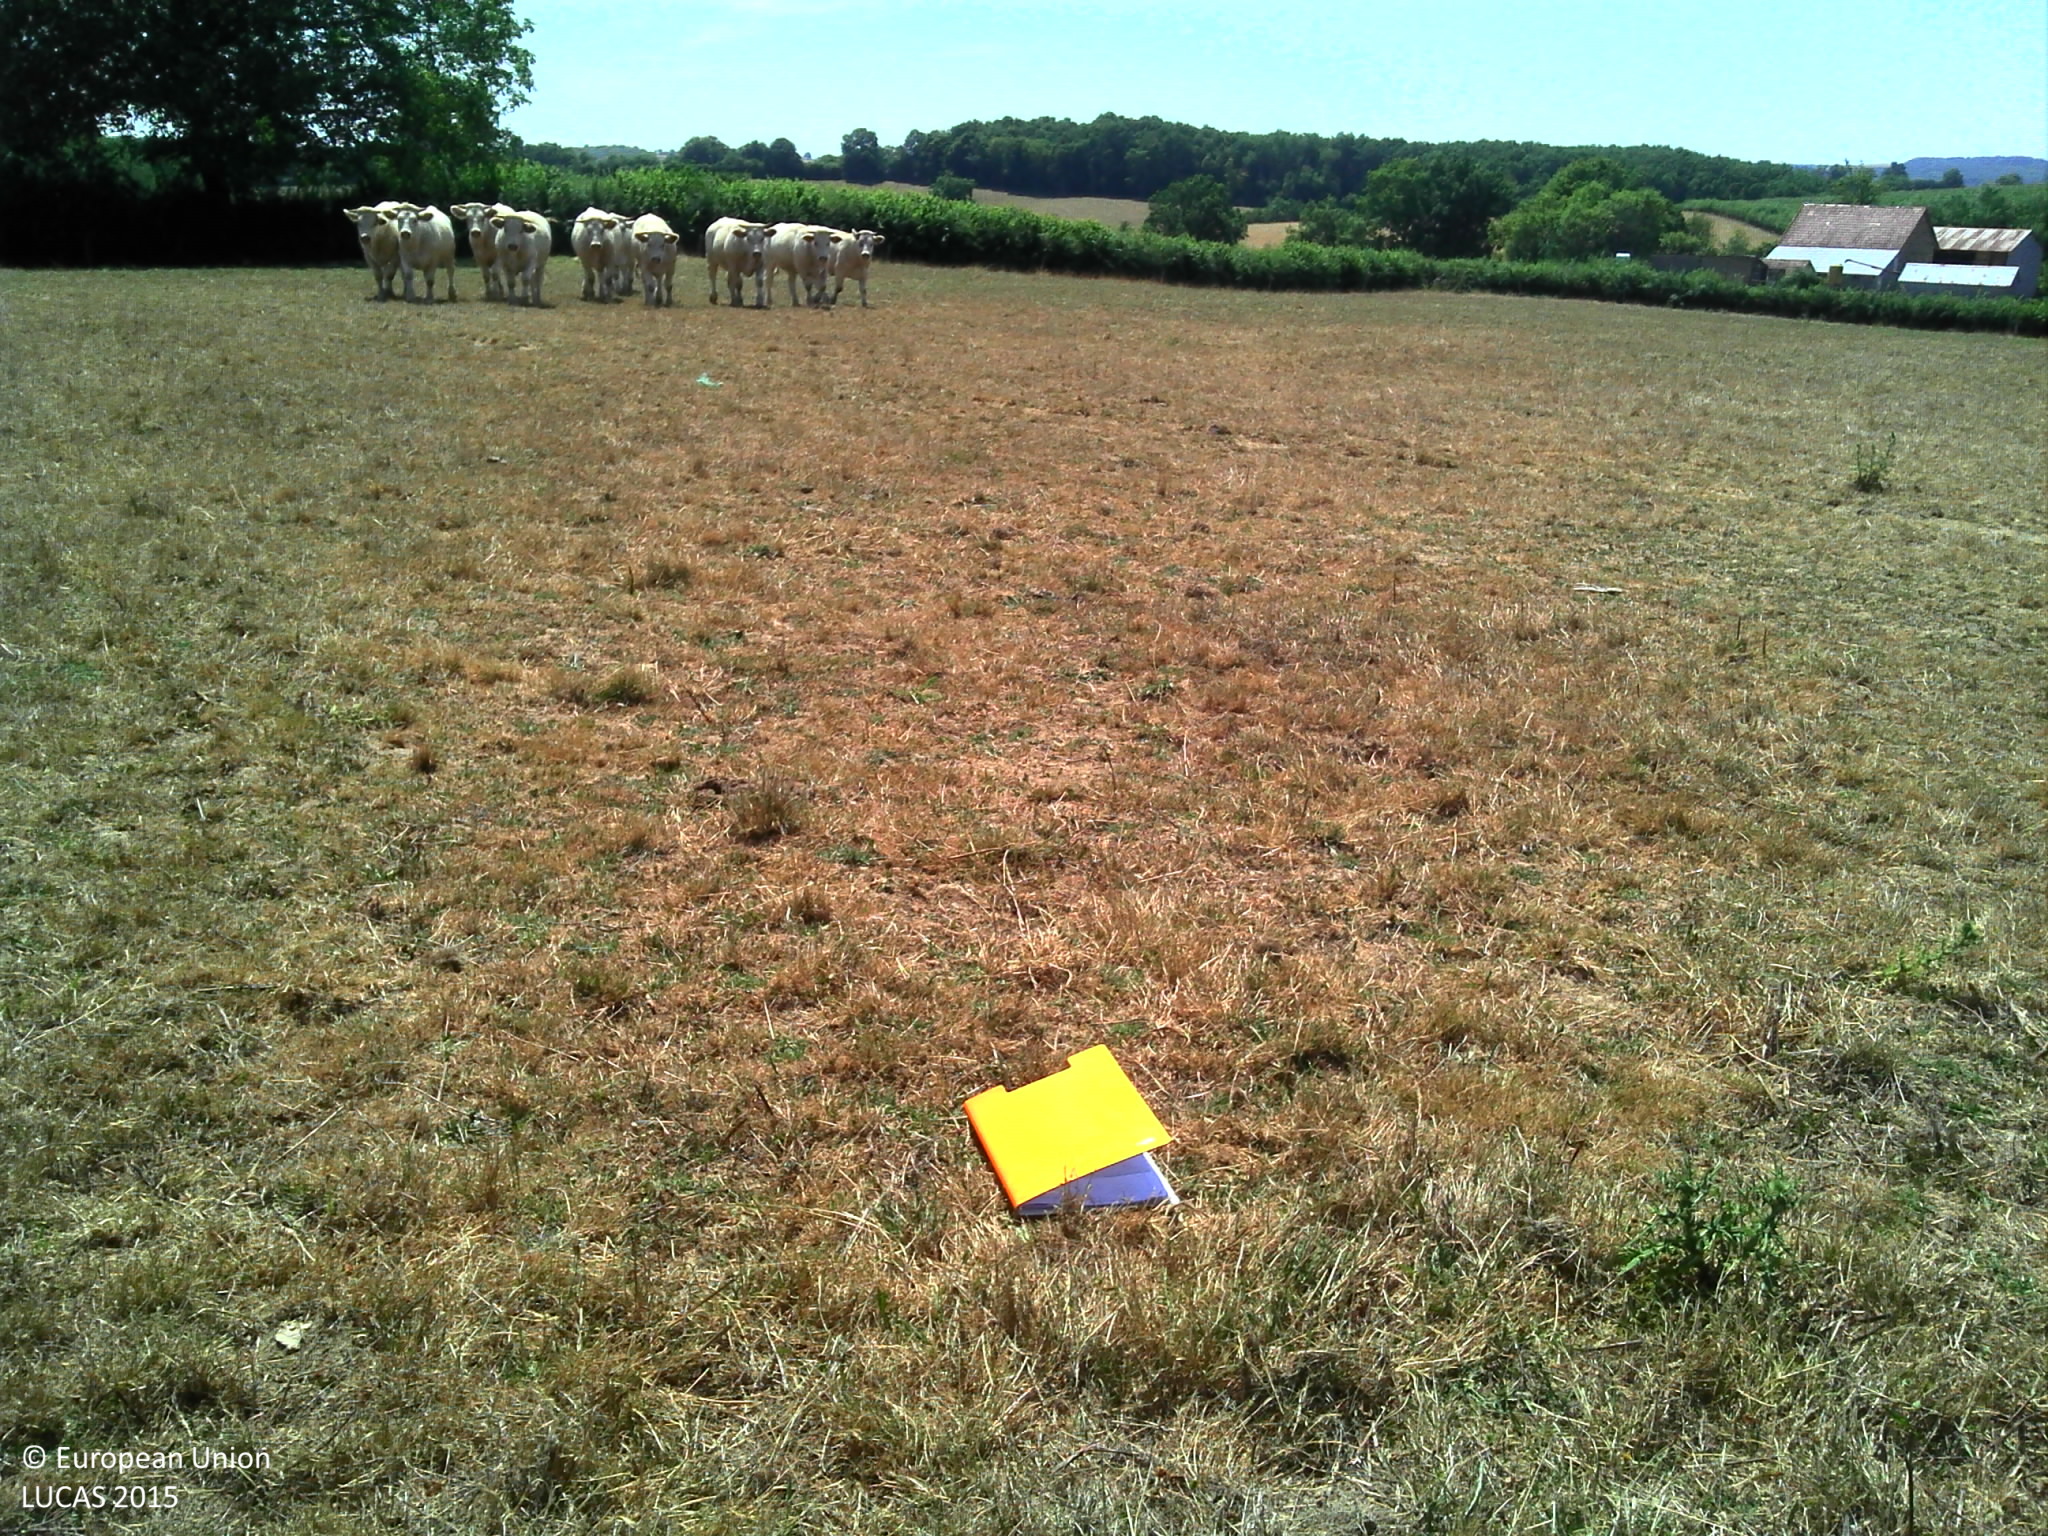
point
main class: Grassland
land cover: Grassland without tree/shrub cover
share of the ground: > 75 %
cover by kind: herbaceous plants 100 %
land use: Agriculture (excluding fallow land and kitchen gardens)
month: July
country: FR
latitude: 46.7974
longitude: 4.0120
